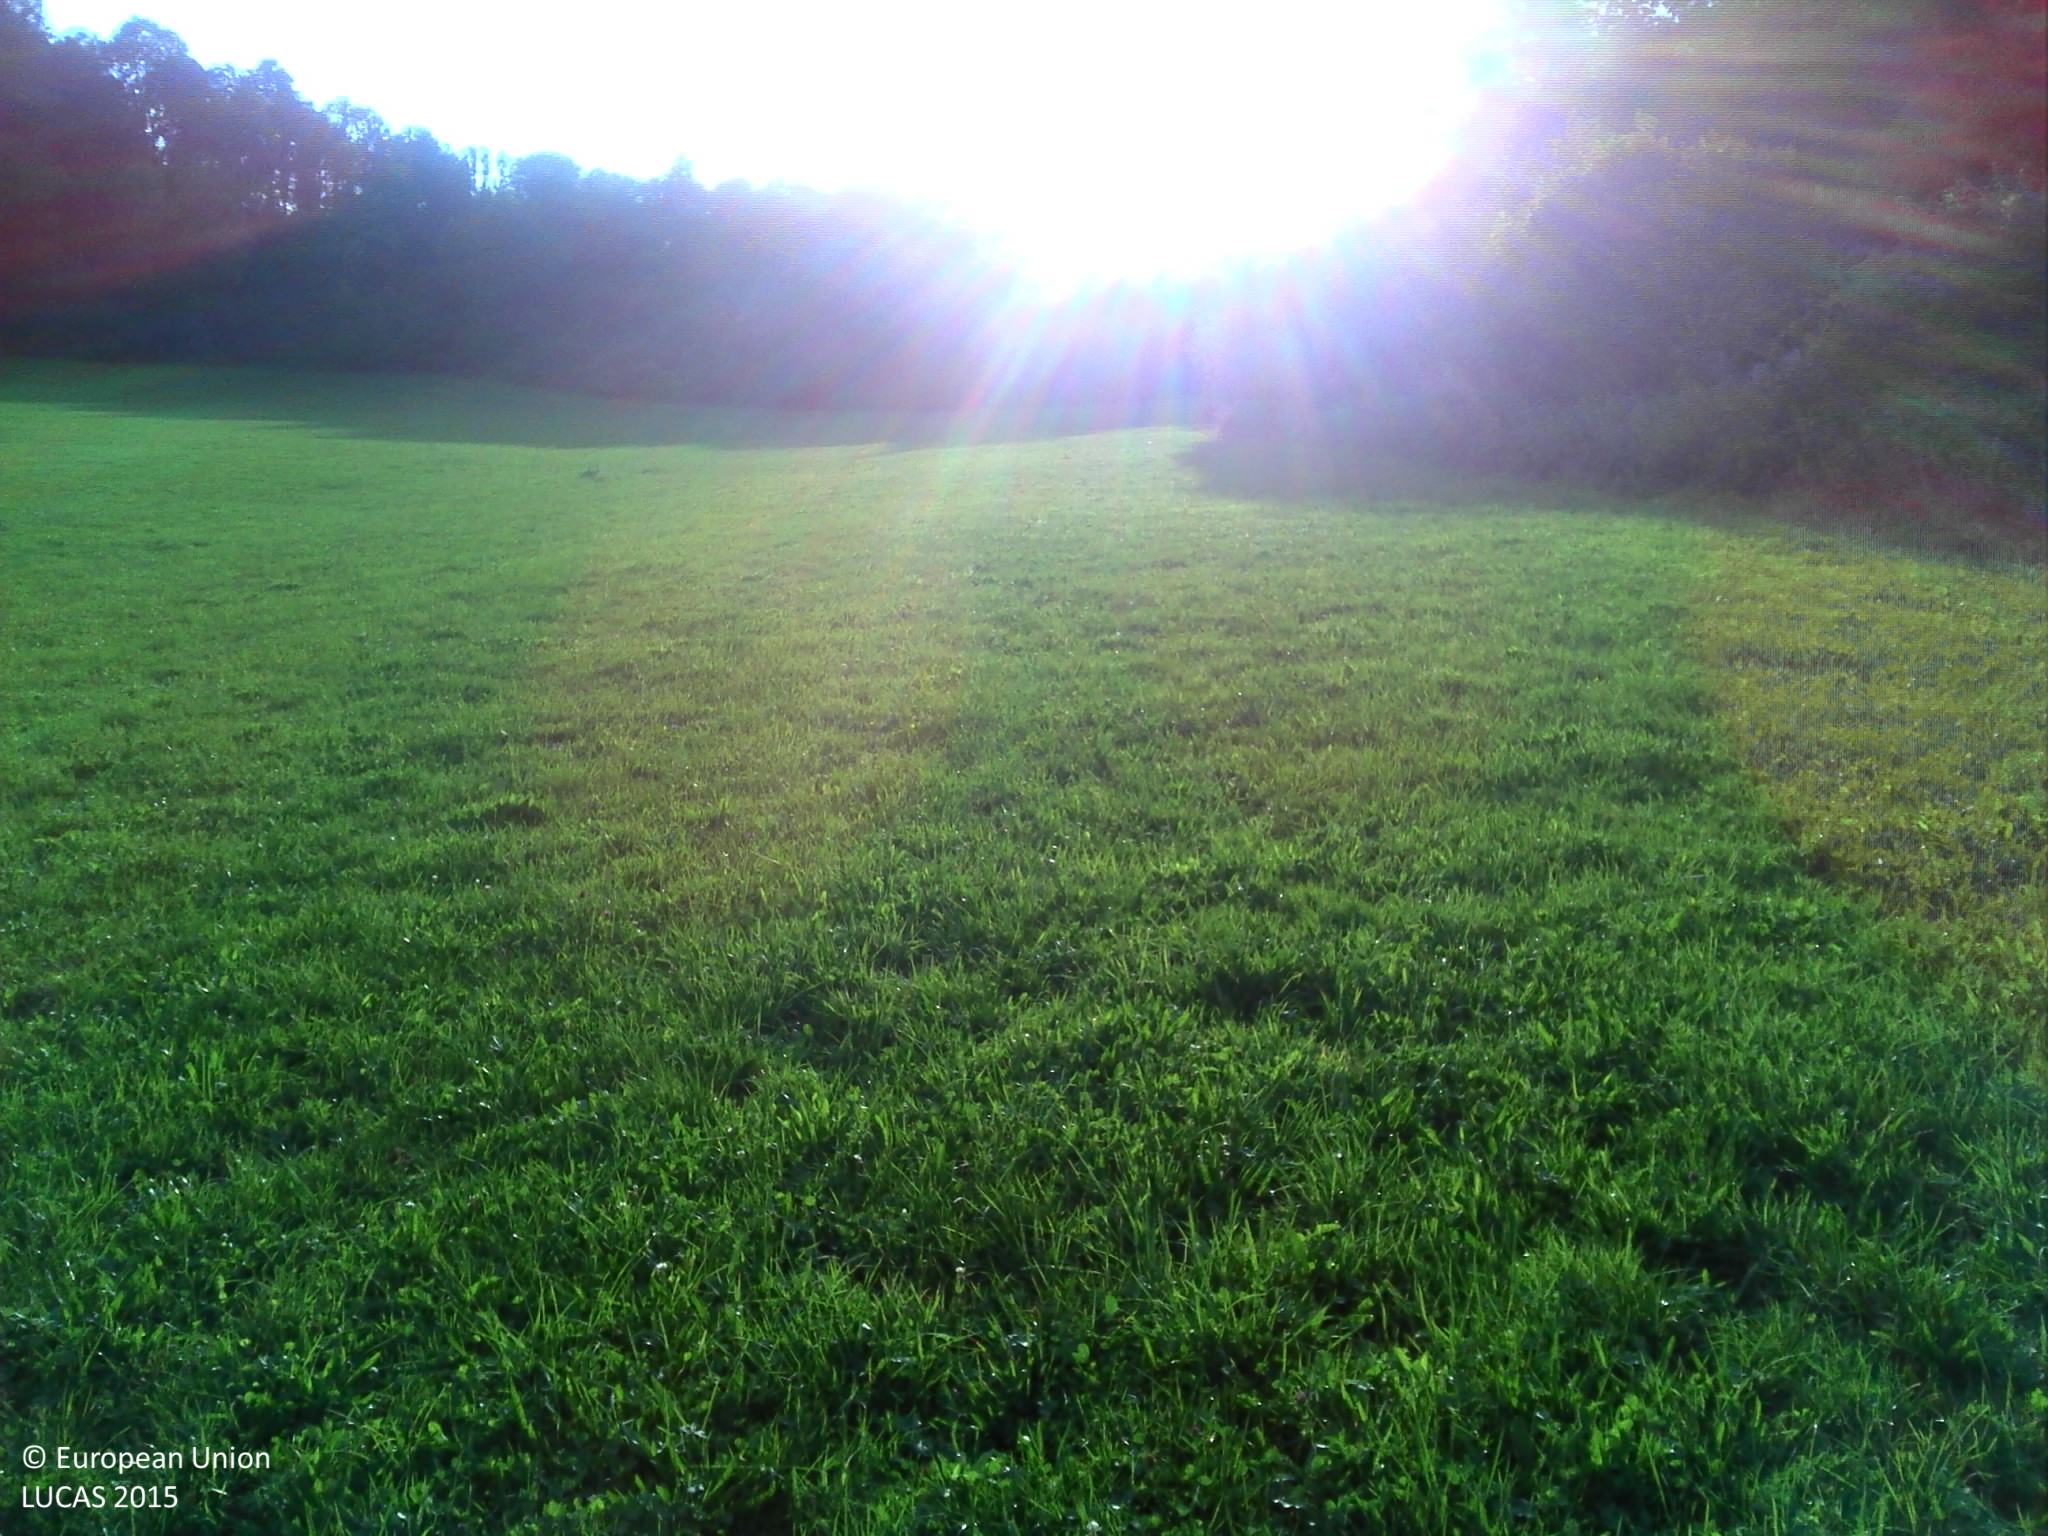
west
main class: Grassland
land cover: Grassland without tree/shrub cover
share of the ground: > 75 %
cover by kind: herbaceous plants 100 %
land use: Agriculture (excluding fallow land and kitchen gardens)
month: September
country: FR
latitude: 47.3708
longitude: 6.3600
